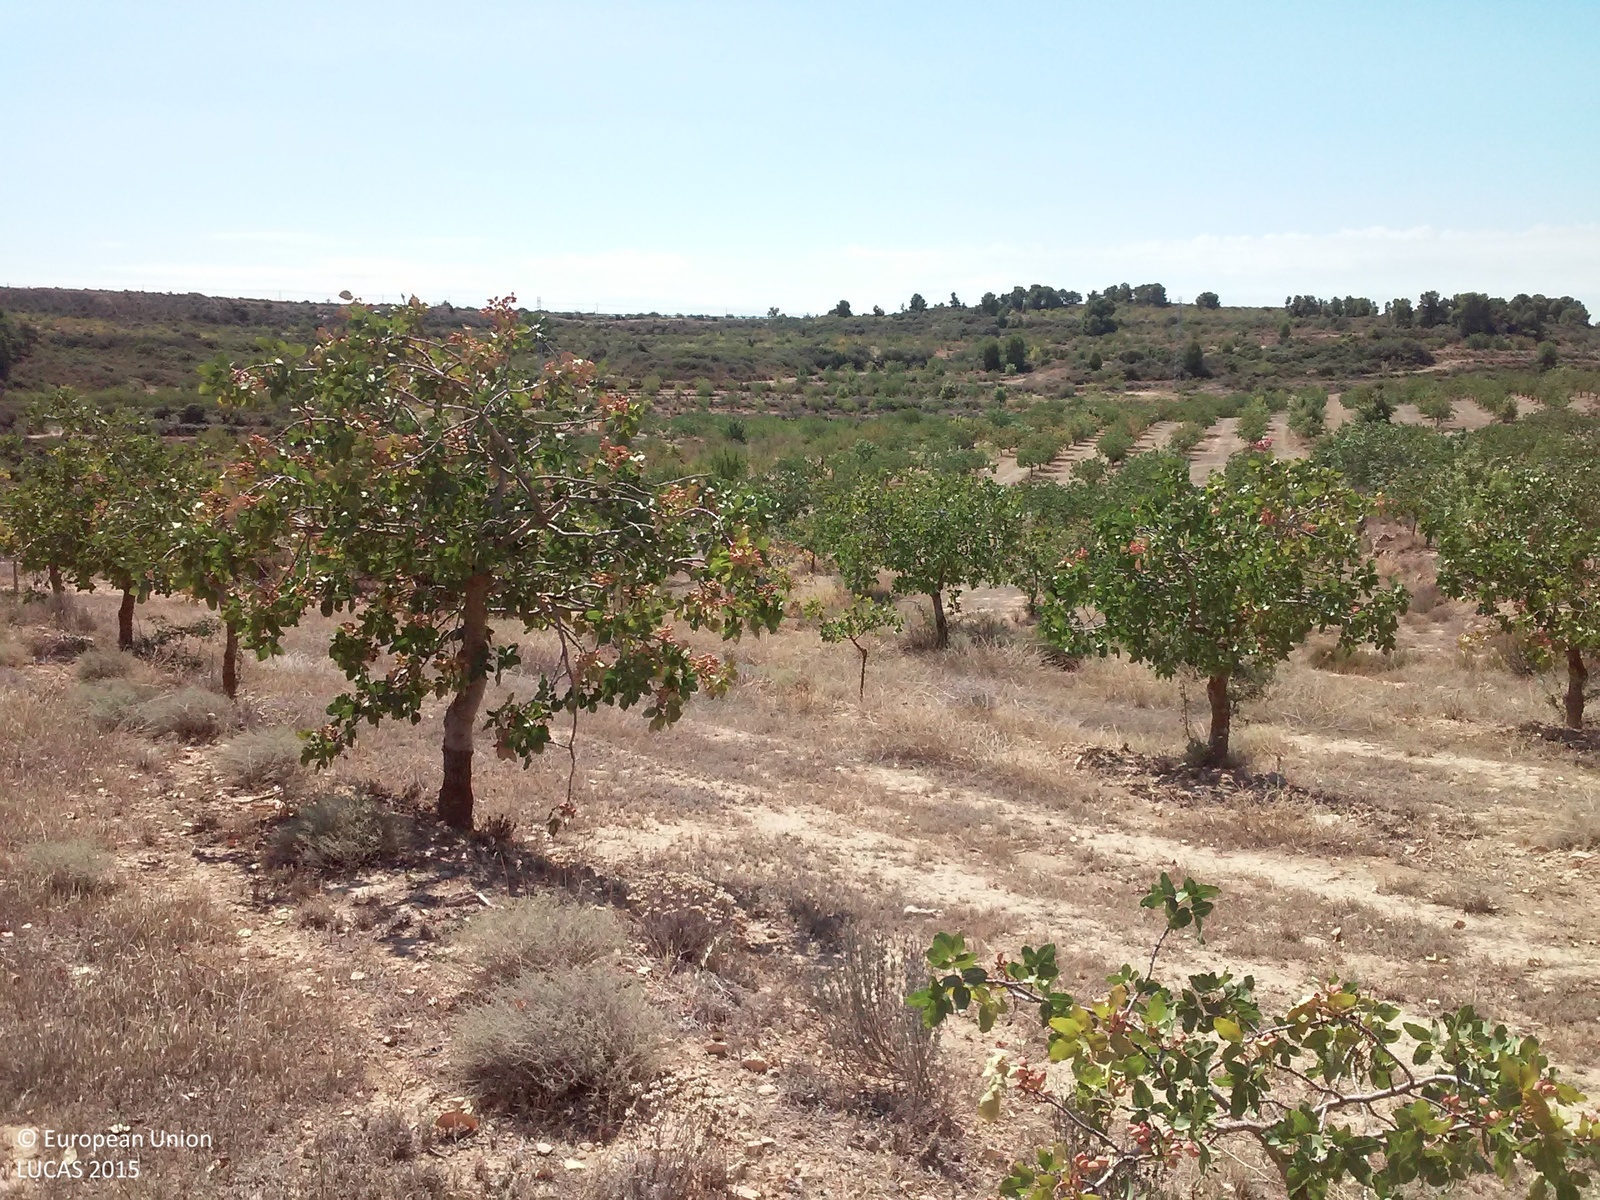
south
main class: Cropland
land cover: Nuts trees
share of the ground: > 75 %
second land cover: Other bare soil
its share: > 75 %
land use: Agriculture (excluding fallow land and kitchen gardens)
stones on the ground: 25 - 50 %
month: August
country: ES
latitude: 41.3734
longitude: 0.5318
